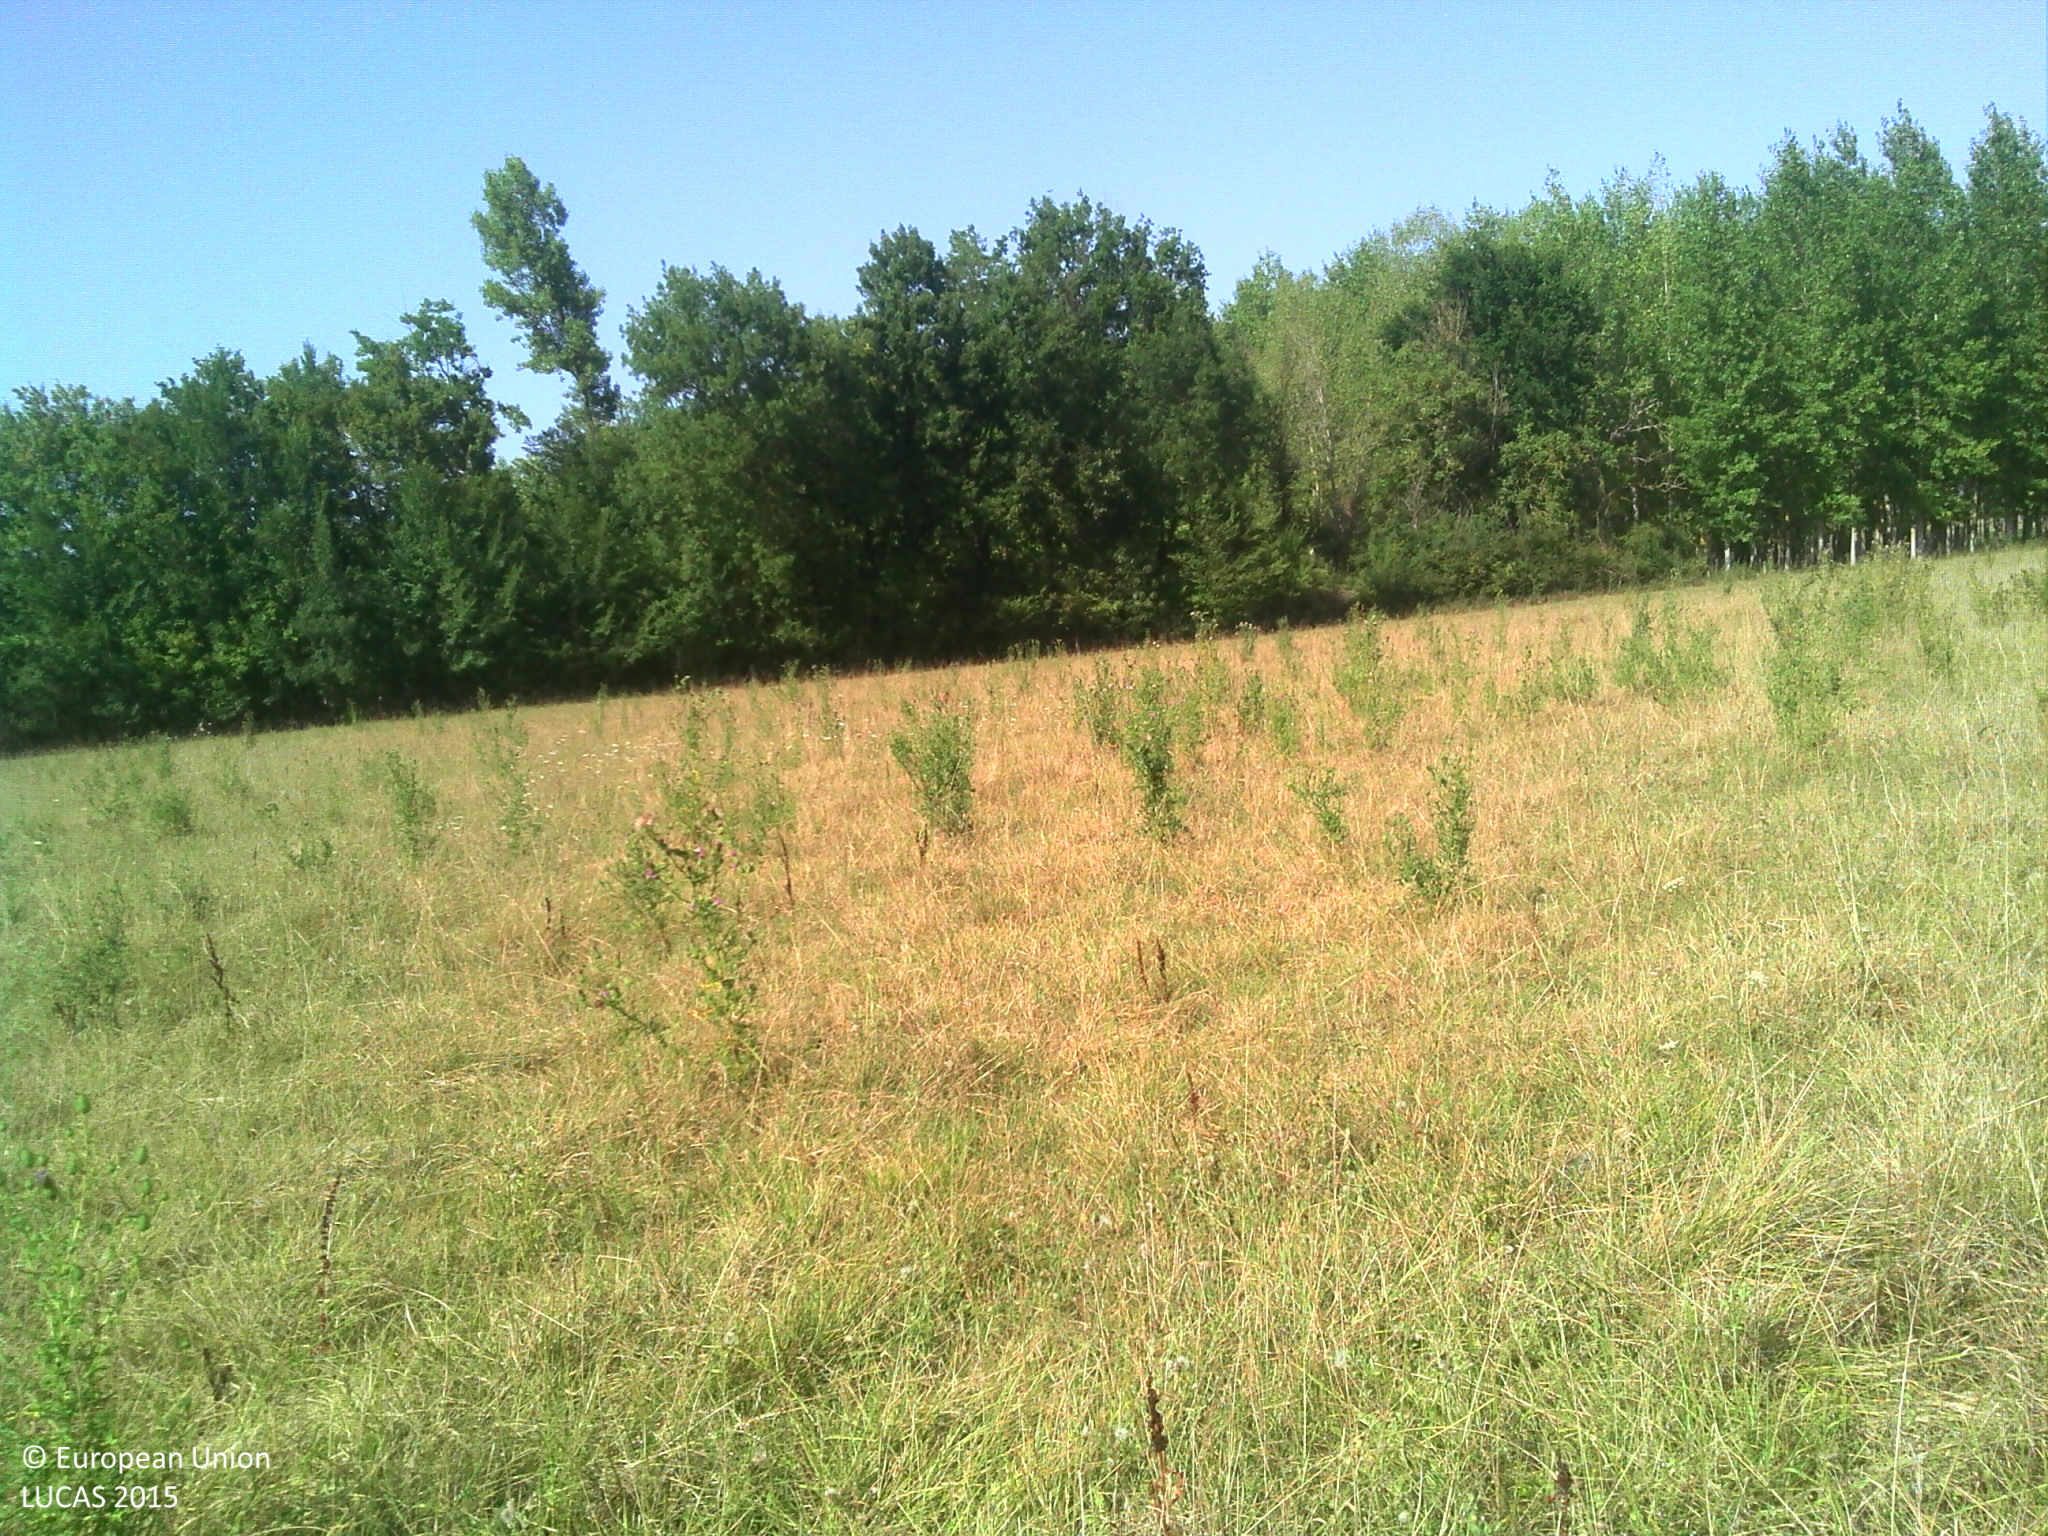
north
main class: Grassland
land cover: Grassland without tree/shrub cover
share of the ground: > 75 %
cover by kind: herbaceous plants 100 %
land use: Agriculture (excluding fallow land and kitchen gardens)
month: August
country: FR
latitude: 44.1666
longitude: 1.3073
